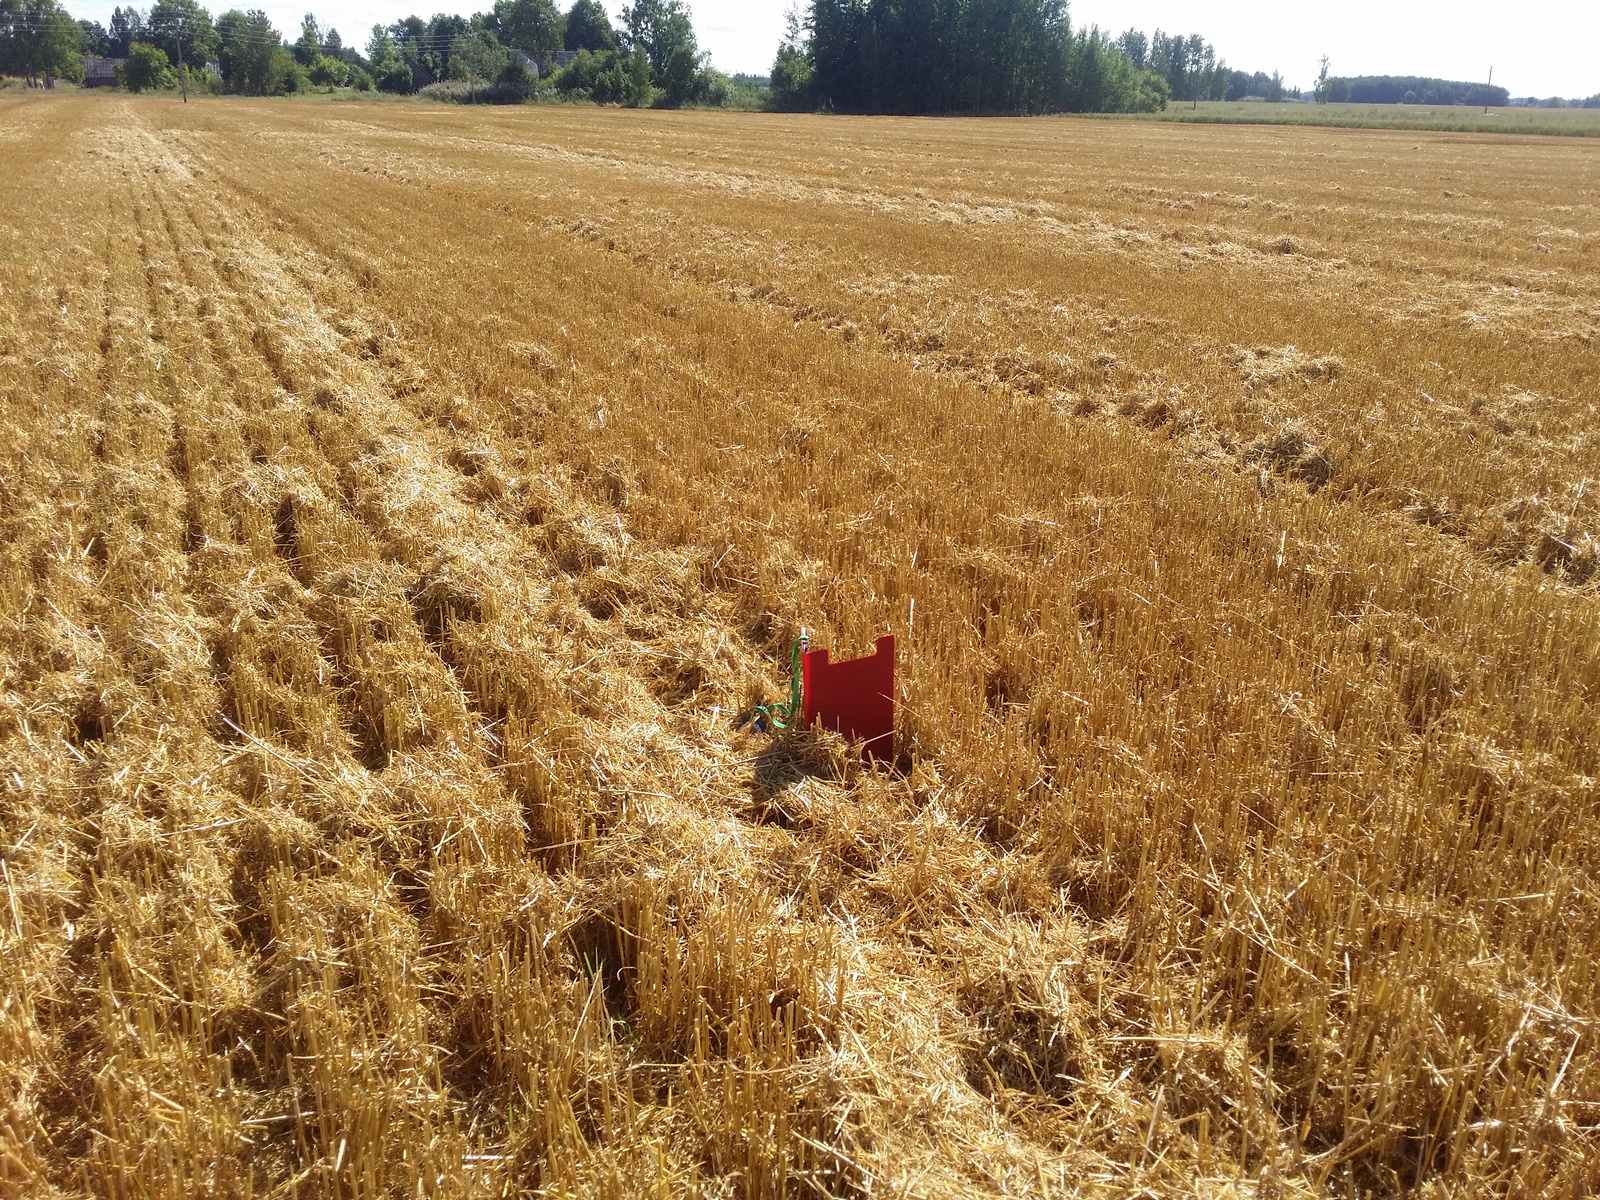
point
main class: Cropland
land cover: Common wheat
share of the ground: 50 - 75 %
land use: Agriculture (excluding fallow land and kitchen gardens)
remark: Harvested field
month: August
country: LV
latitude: 57.0168
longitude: 27.6567
